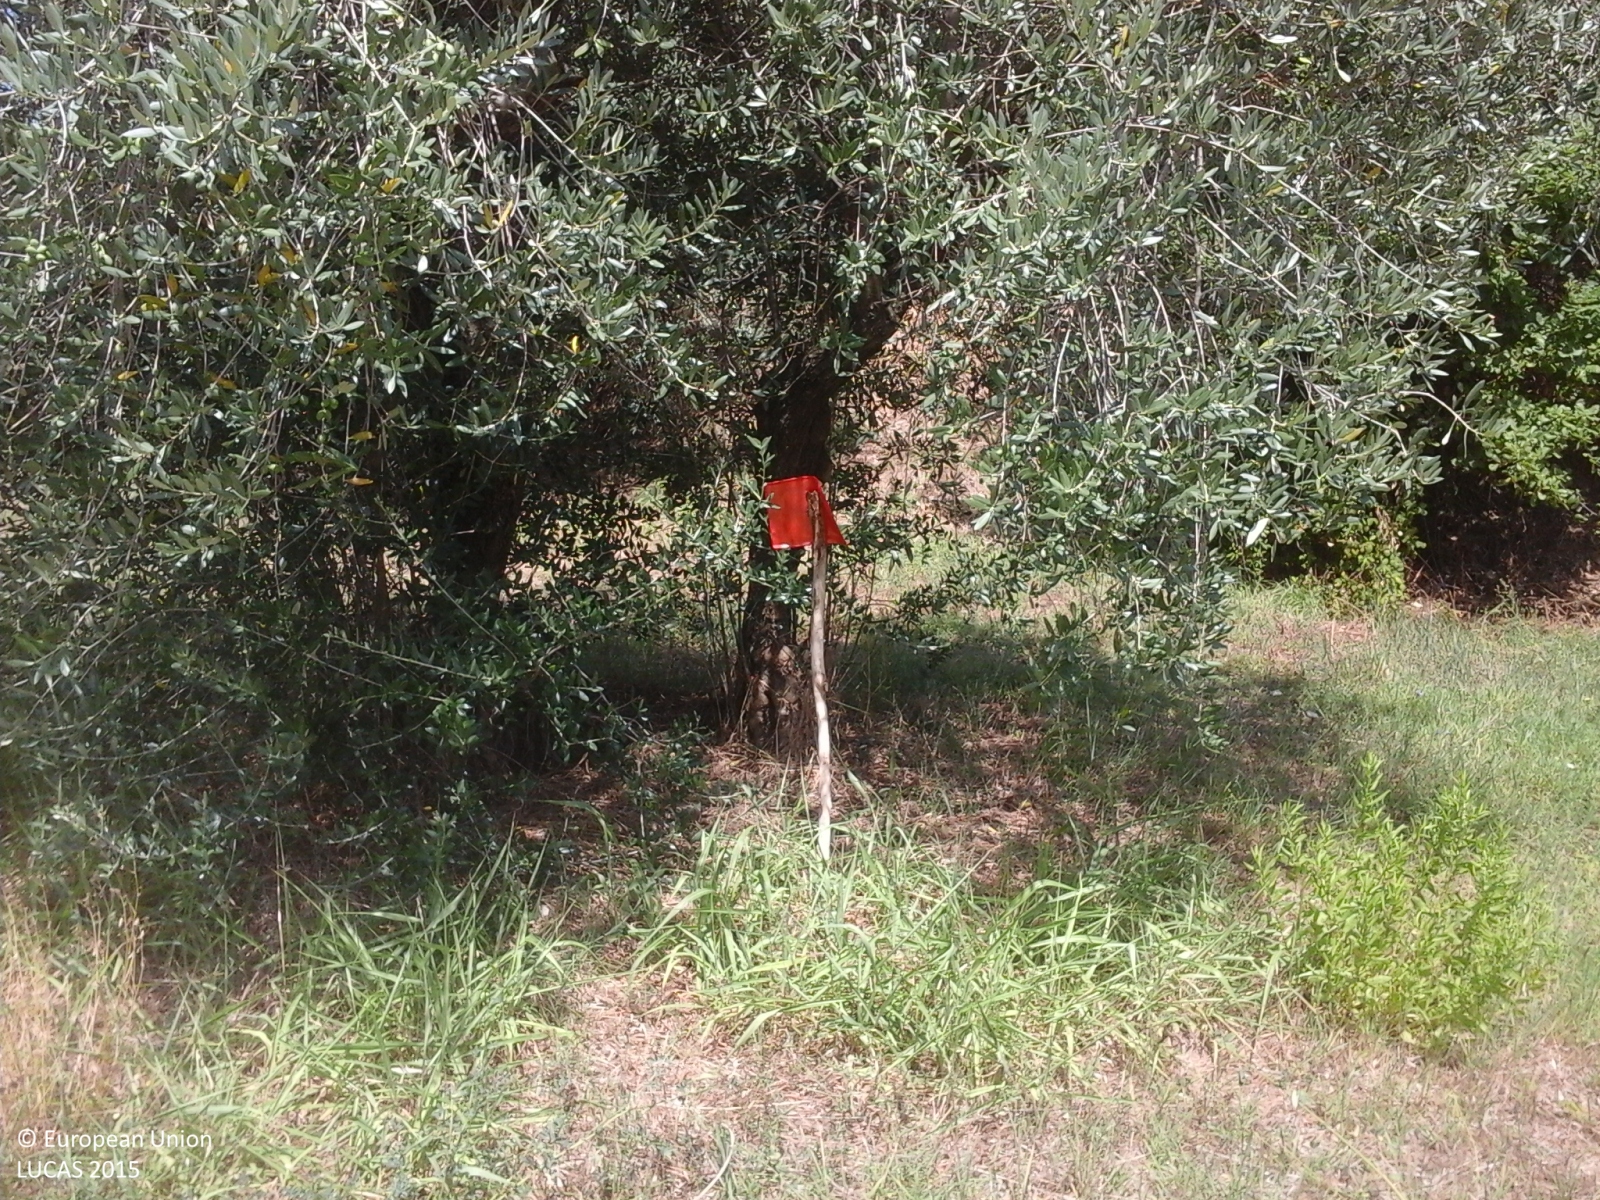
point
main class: Cropland
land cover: Olive groves
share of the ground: > 75 %
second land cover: Grassland without tree/shrub cover
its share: > 75 %
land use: Agriculture (excluding fallow land and kitchen gardens)
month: August
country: IT
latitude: 43.8408
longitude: 10.9800
